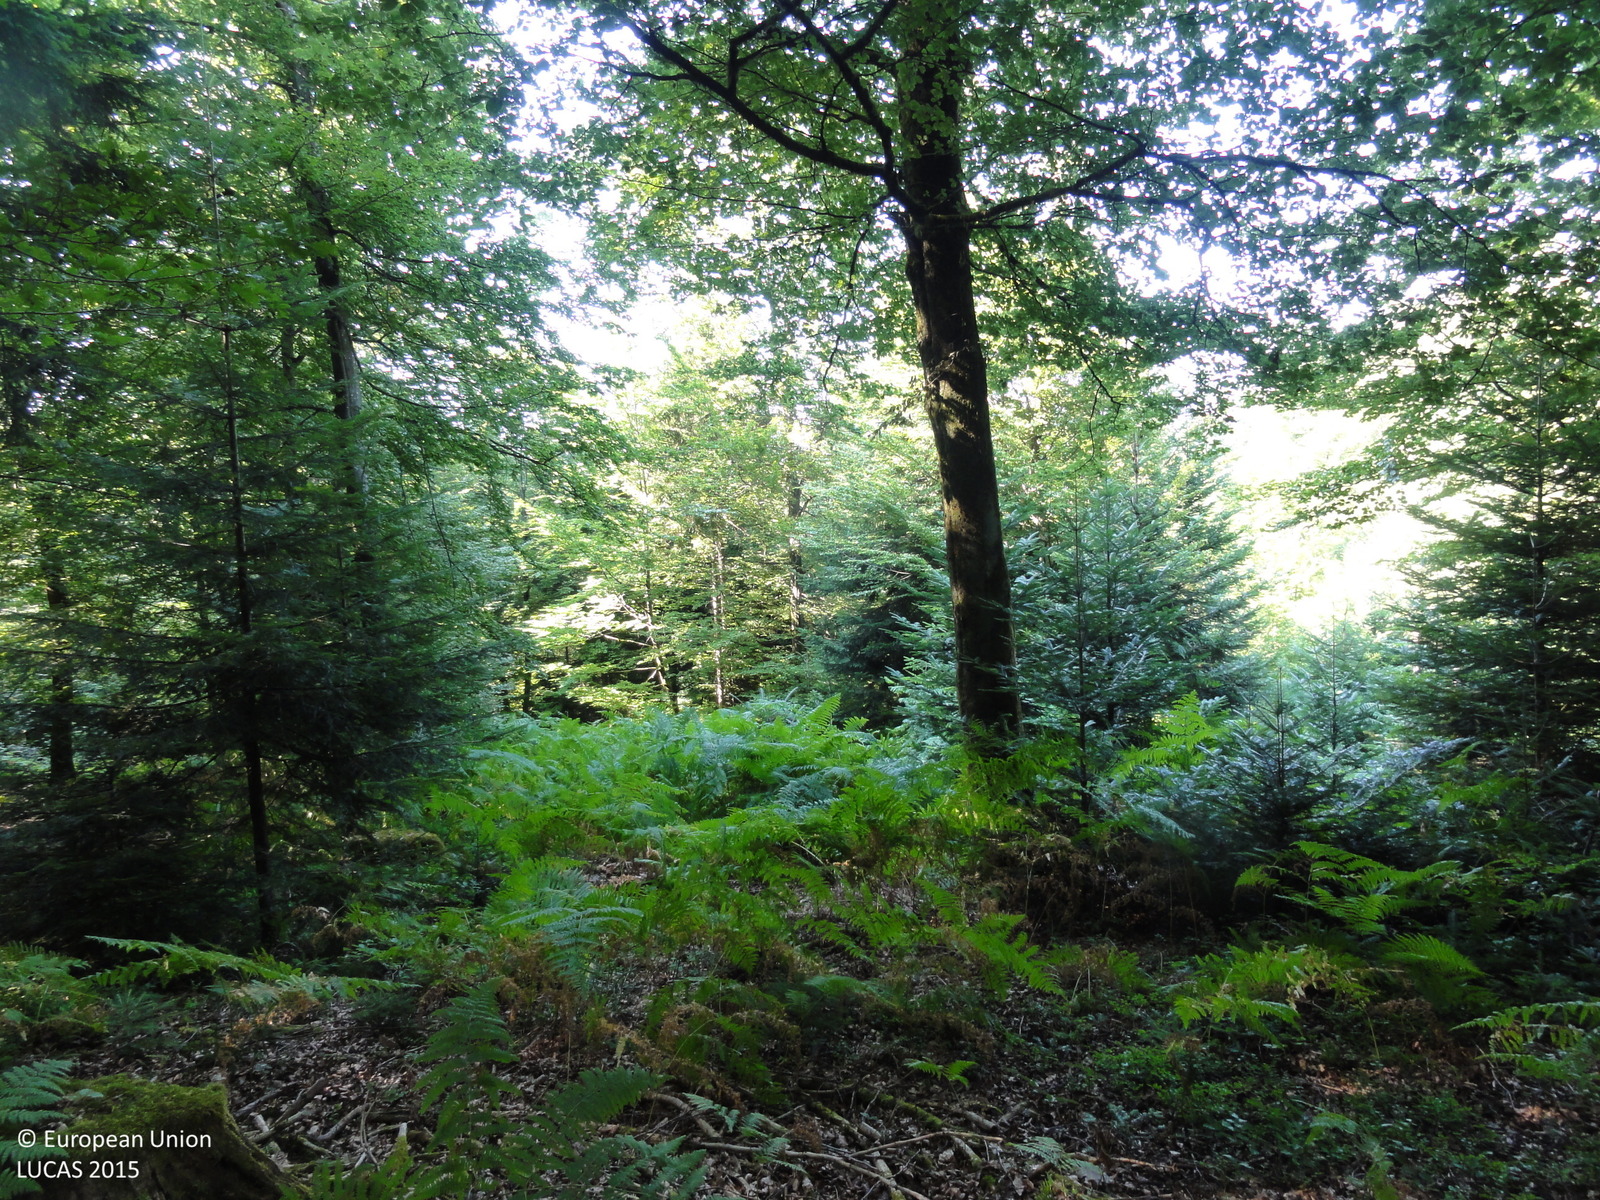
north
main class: Woodland
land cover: Spruce dominated mixed woodland
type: hemiboreal forest and nemoral coniferous forest and mixed broadleaved-coniferous forest
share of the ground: > 75 %
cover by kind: coniferous forest trees 40 %, broadleaved forest trees 40 %, shrubs 10 %, herbaceous plants 10 %
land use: Forestry
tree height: > 5 m
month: July
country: SI
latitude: 45.9173
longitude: 14.8314
